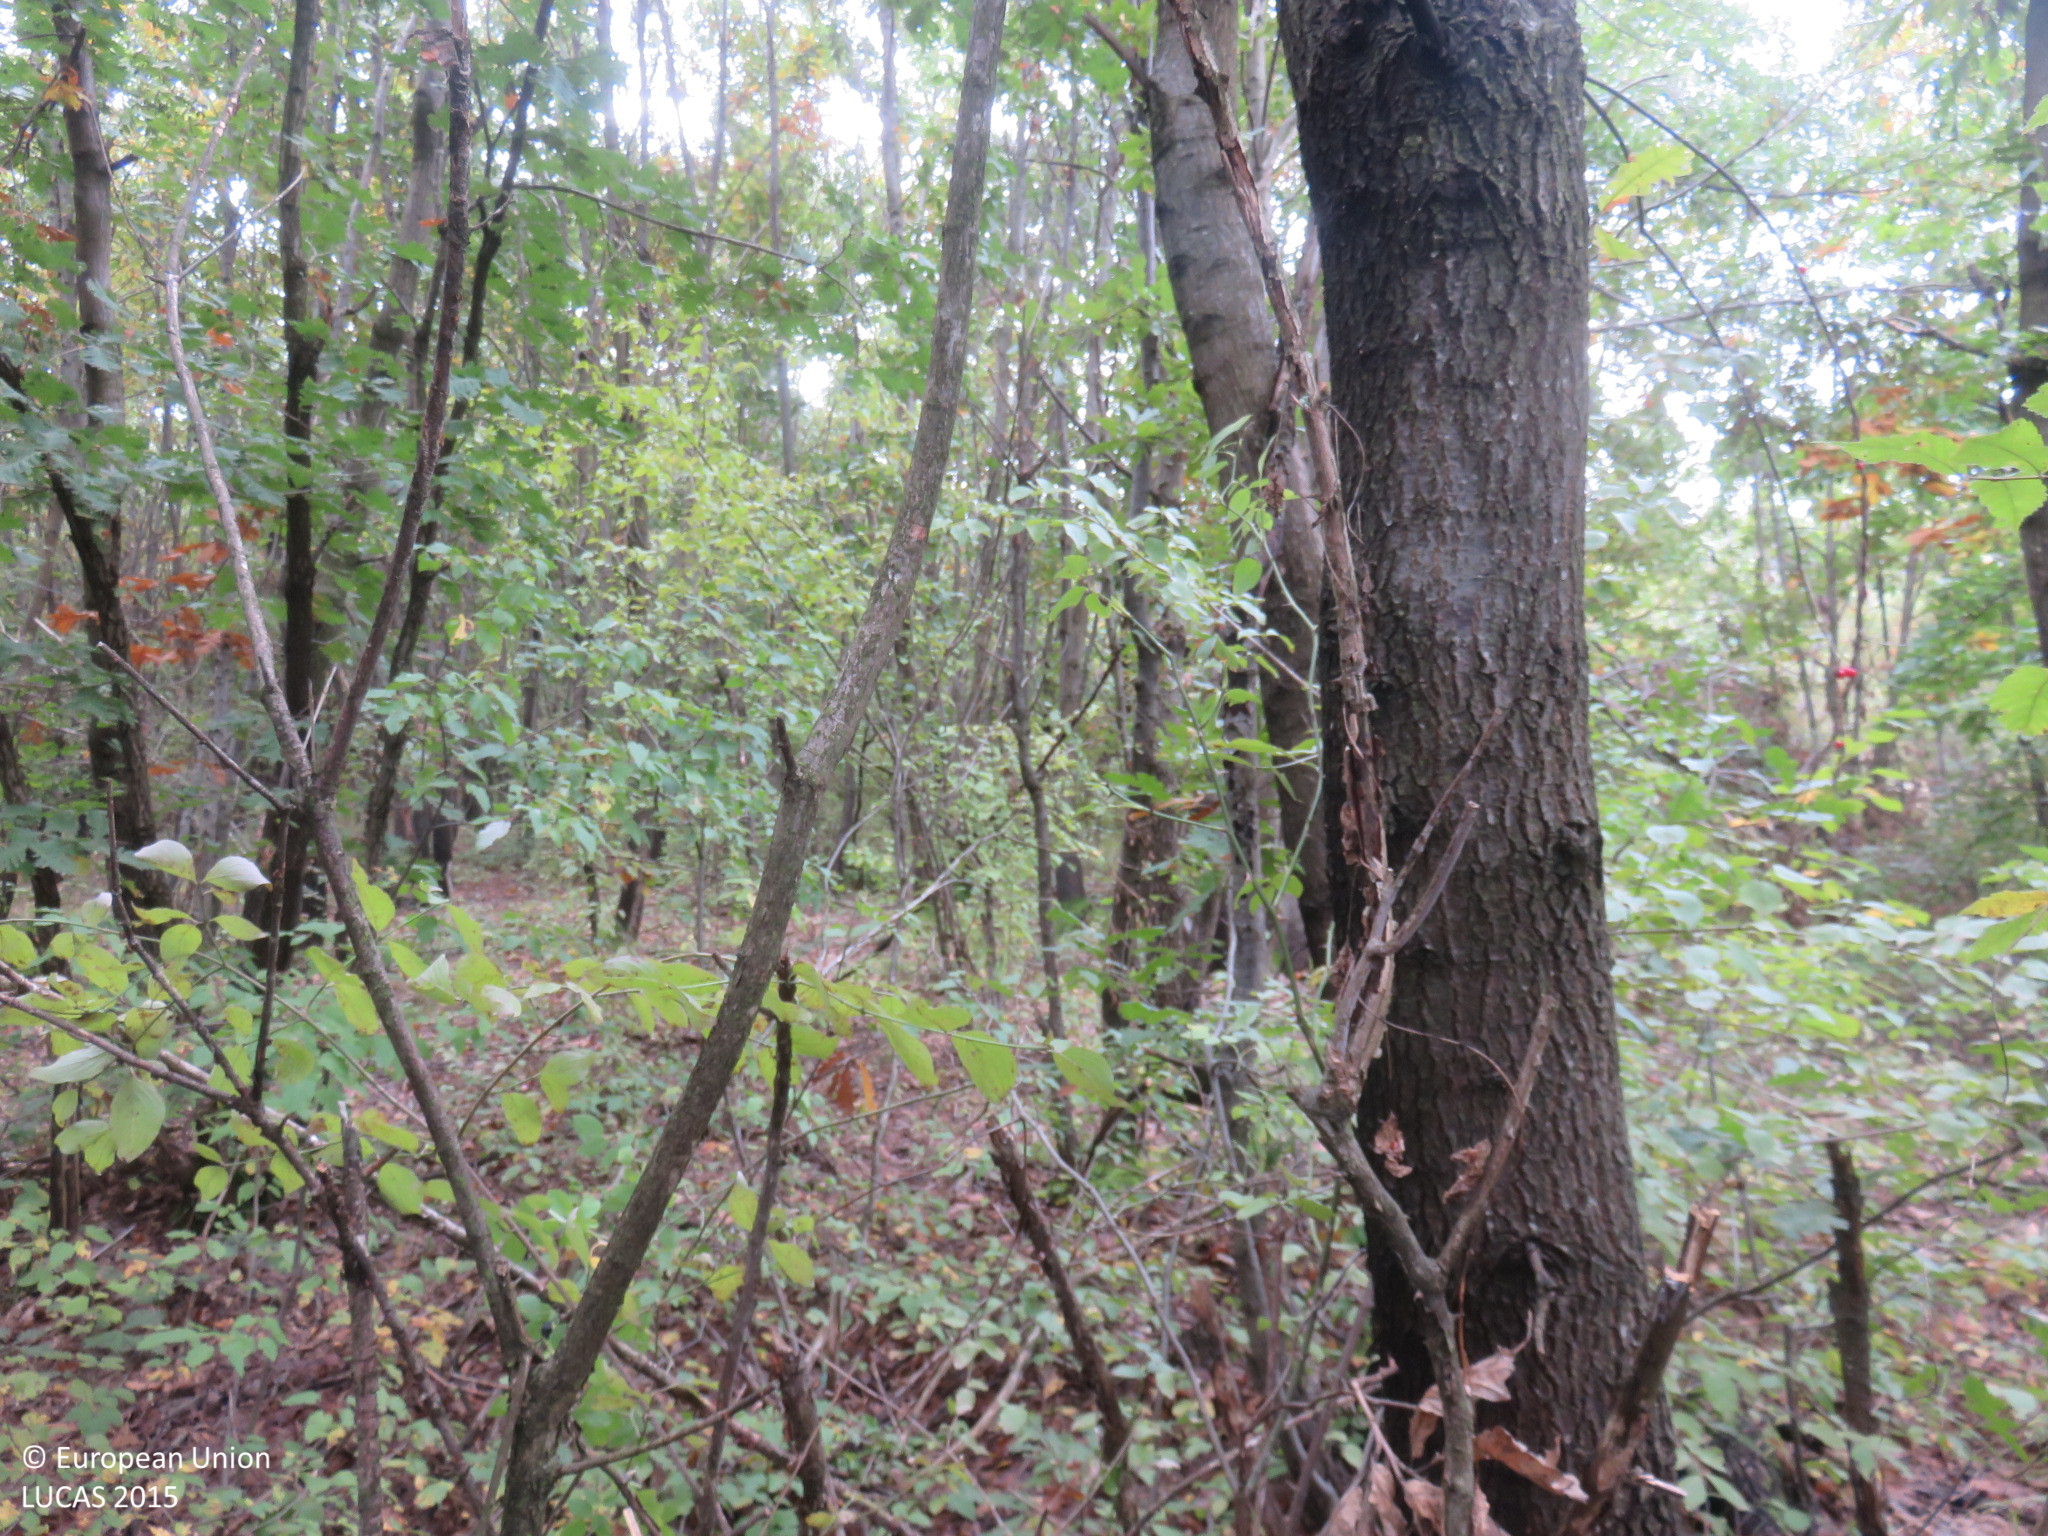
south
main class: Woodland
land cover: Broadleaved woodland
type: mesophytic deciduous forest
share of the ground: > 75 %
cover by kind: broadleaved forest trees 100 %
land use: Forestry
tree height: > 5 m
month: October
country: BG
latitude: 43.0919
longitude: 25.2187
